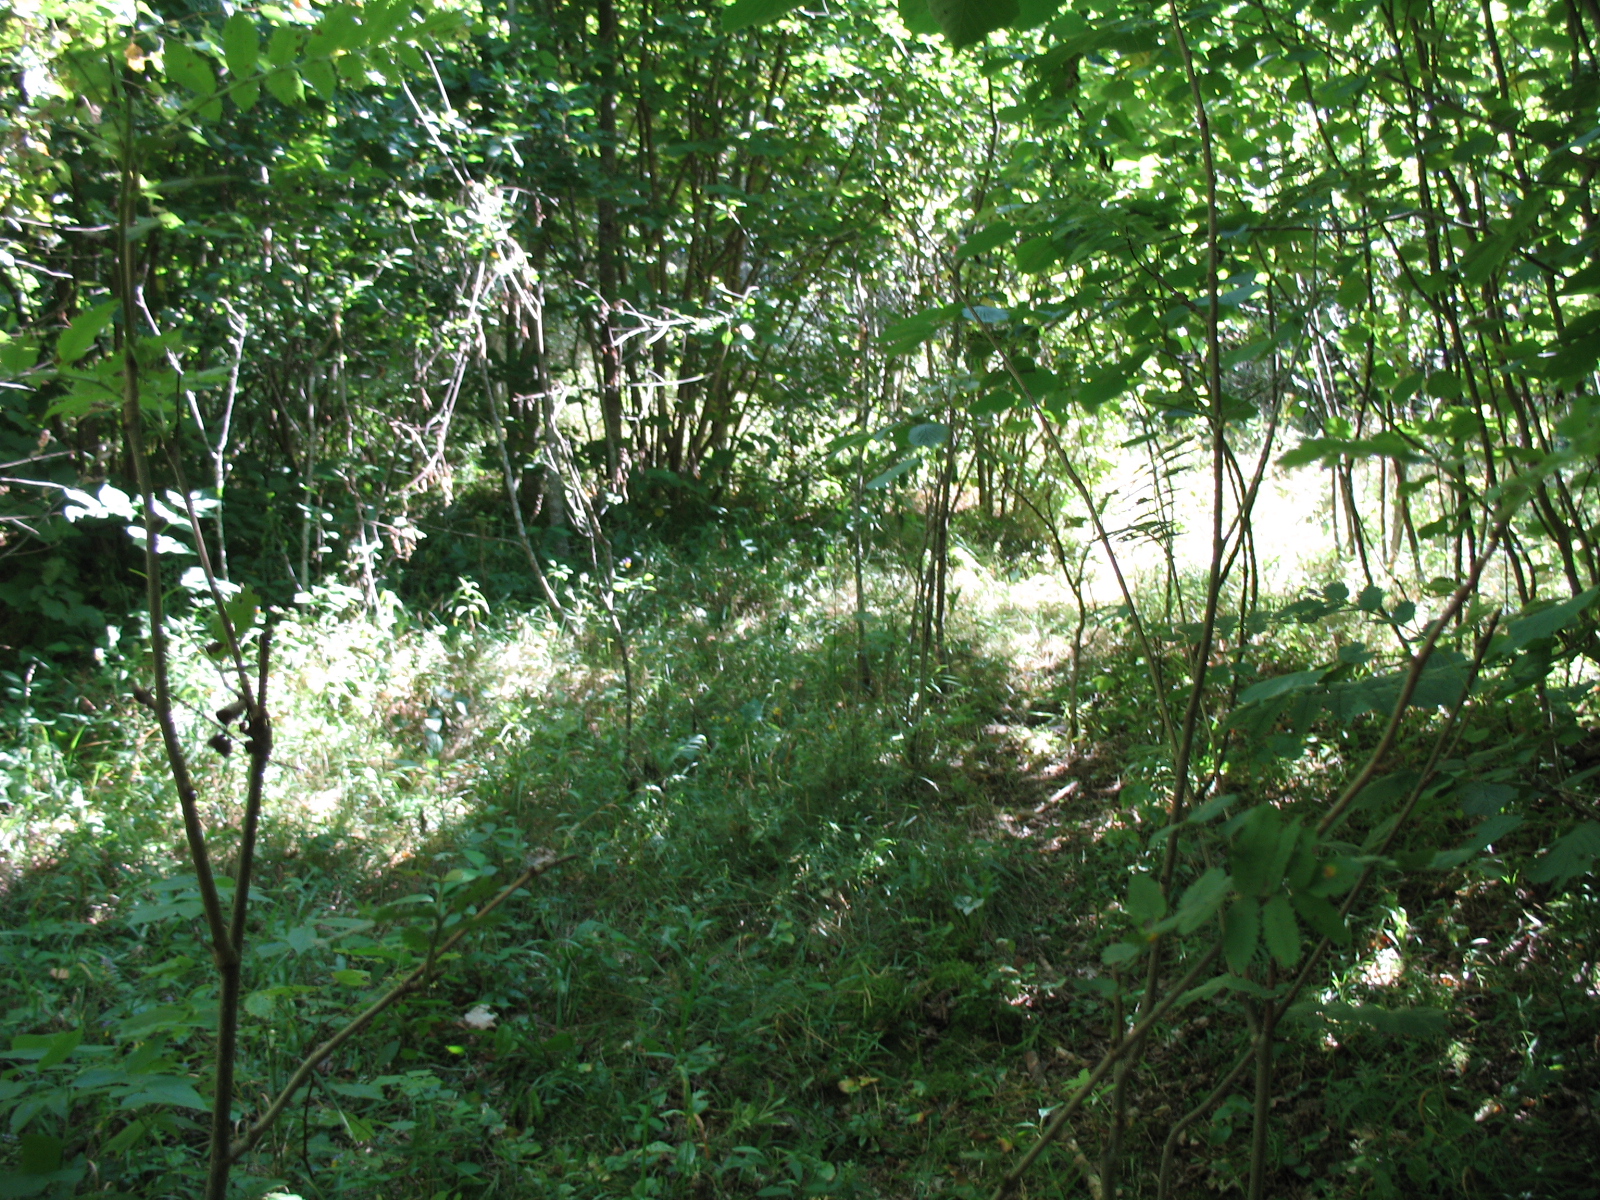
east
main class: Woodland
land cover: Broadleaved woodland
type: non-riverine alder, birch or aspen forest
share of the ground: 50 - 75 %
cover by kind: broadleaved forest trees 70 %, herbaceous plants 25 %, shrubs 5 %
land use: Forestry
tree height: > 5 m
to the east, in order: Broadleaved woodland; Tracks; Other mixed woodland; Spruce dominated mixed woodland
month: August
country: LV
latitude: 56.5362
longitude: 25.6865
